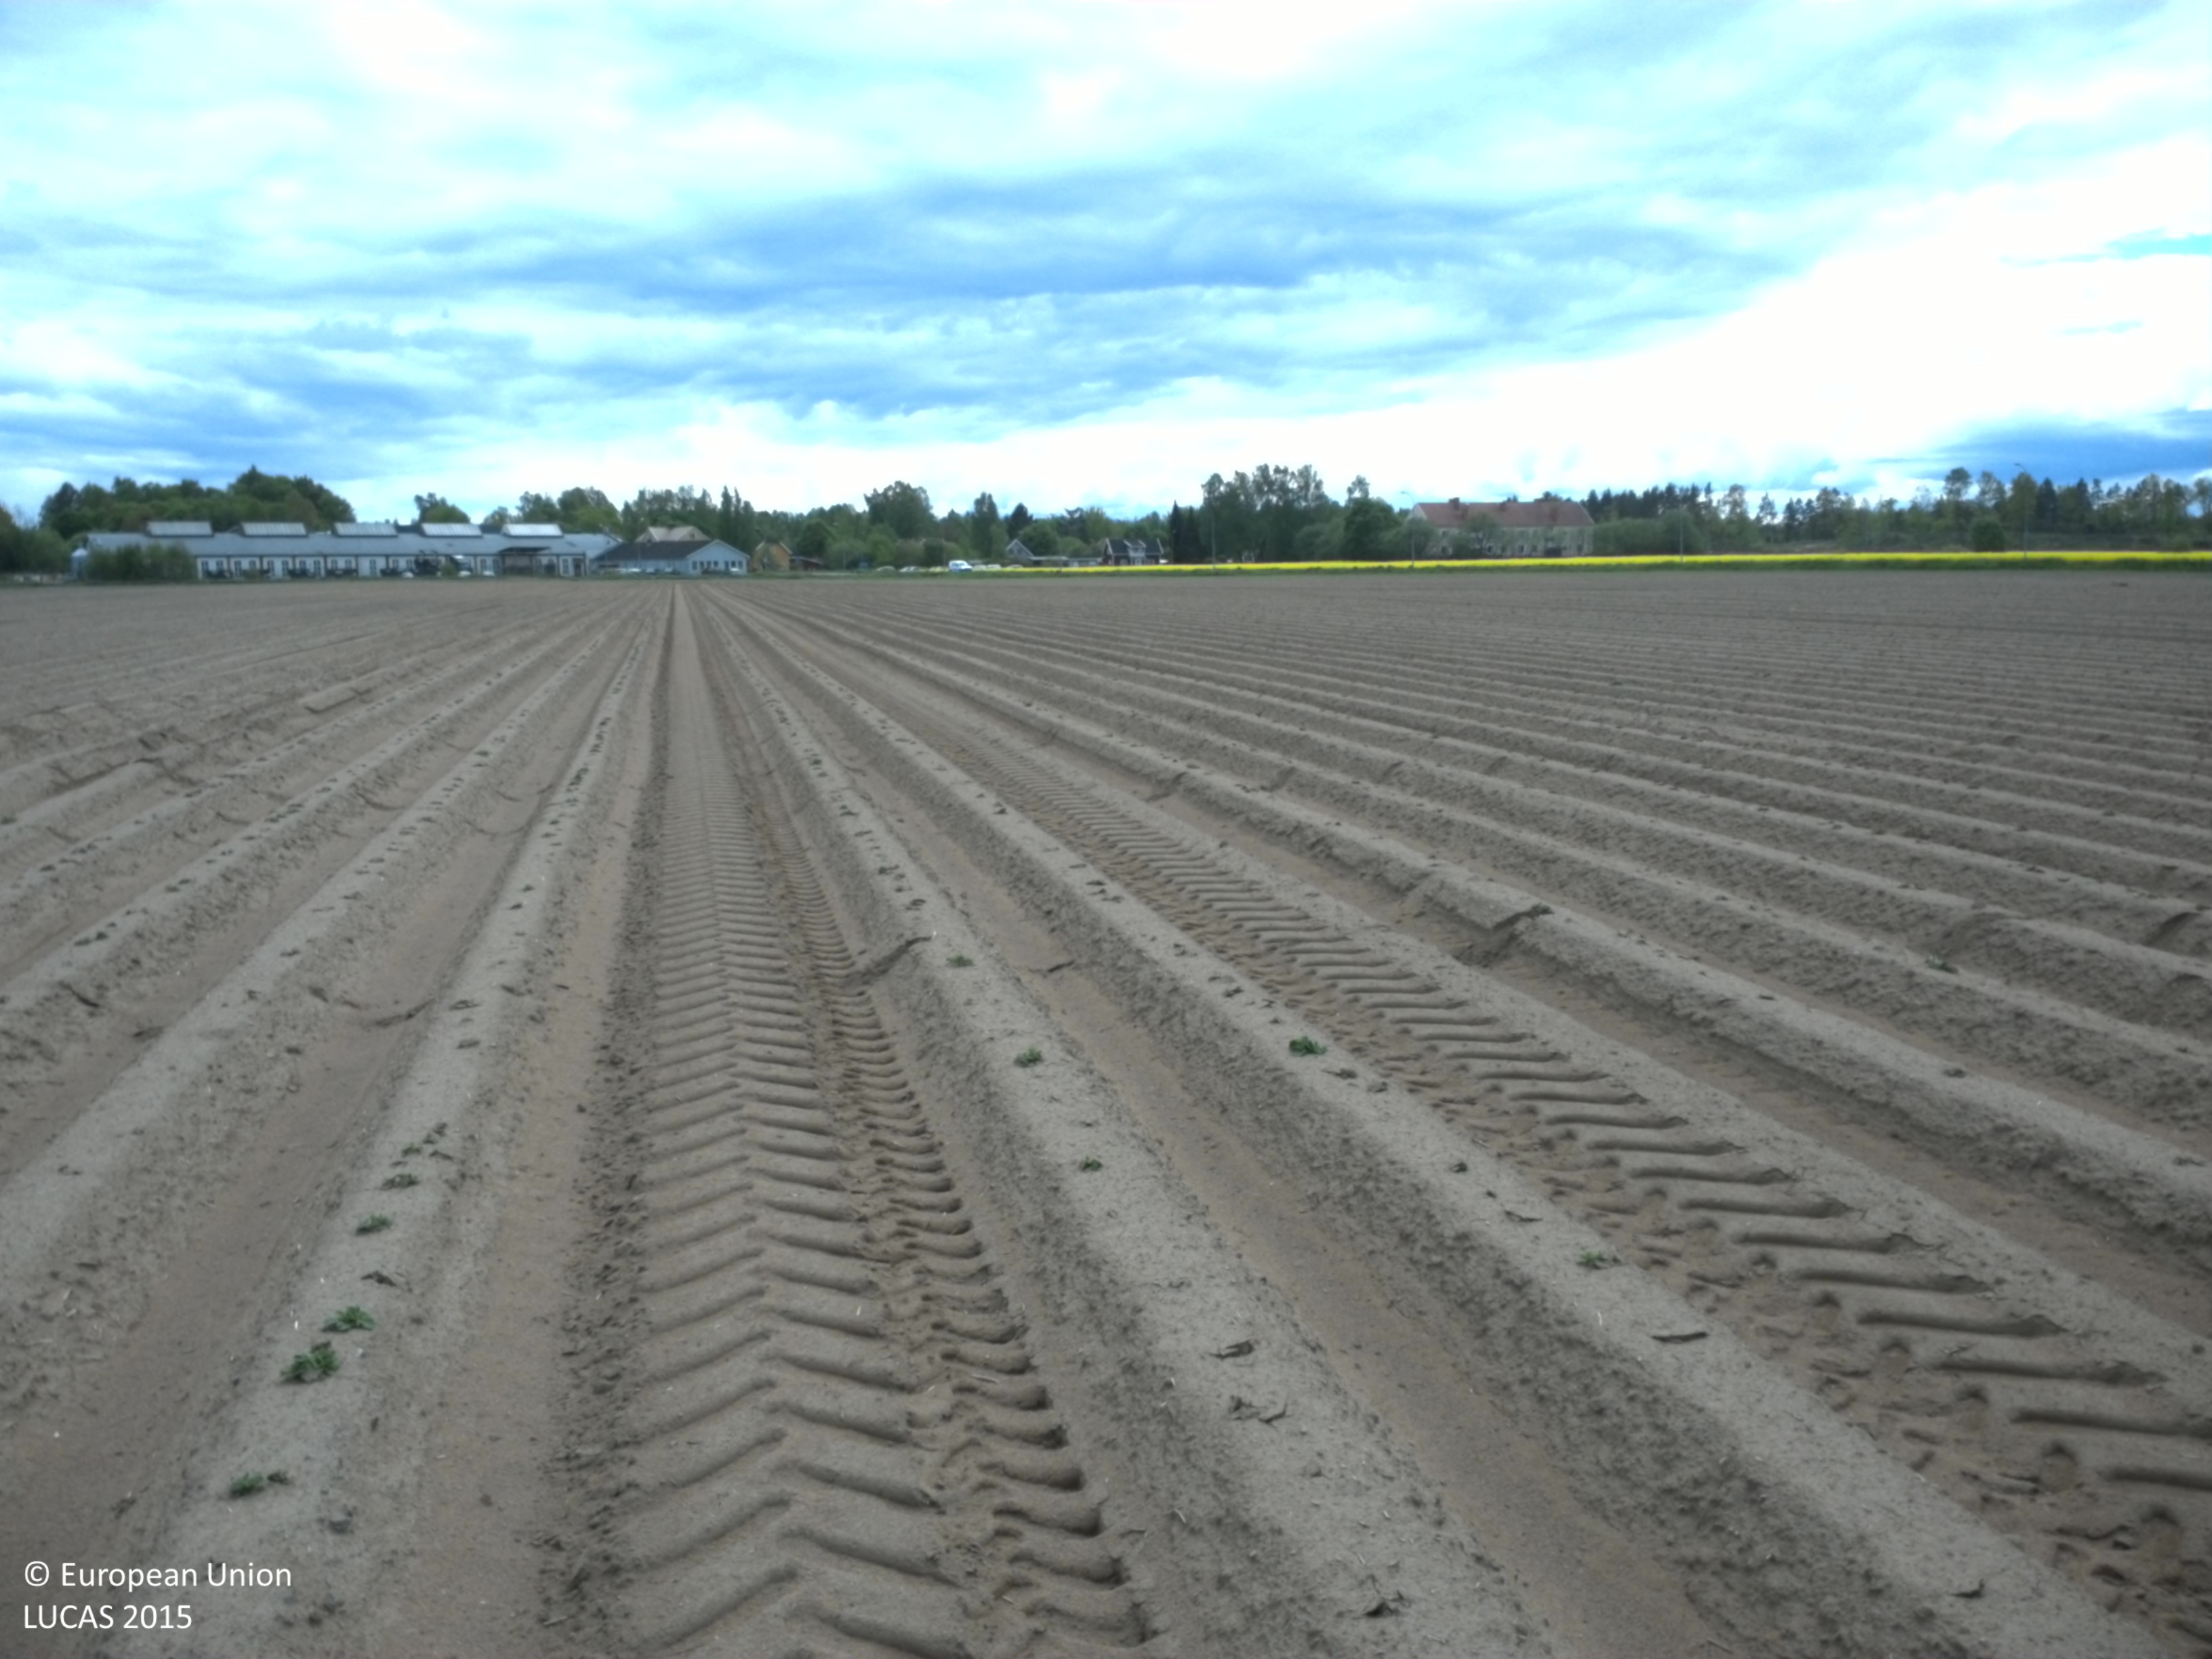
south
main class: Cropland
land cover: Potatoes
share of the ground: < 10 %
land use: Agriculture (excluding fallow land and kitchen gardens)
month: May
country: SE
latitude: 57.3714
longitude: 15.8345
